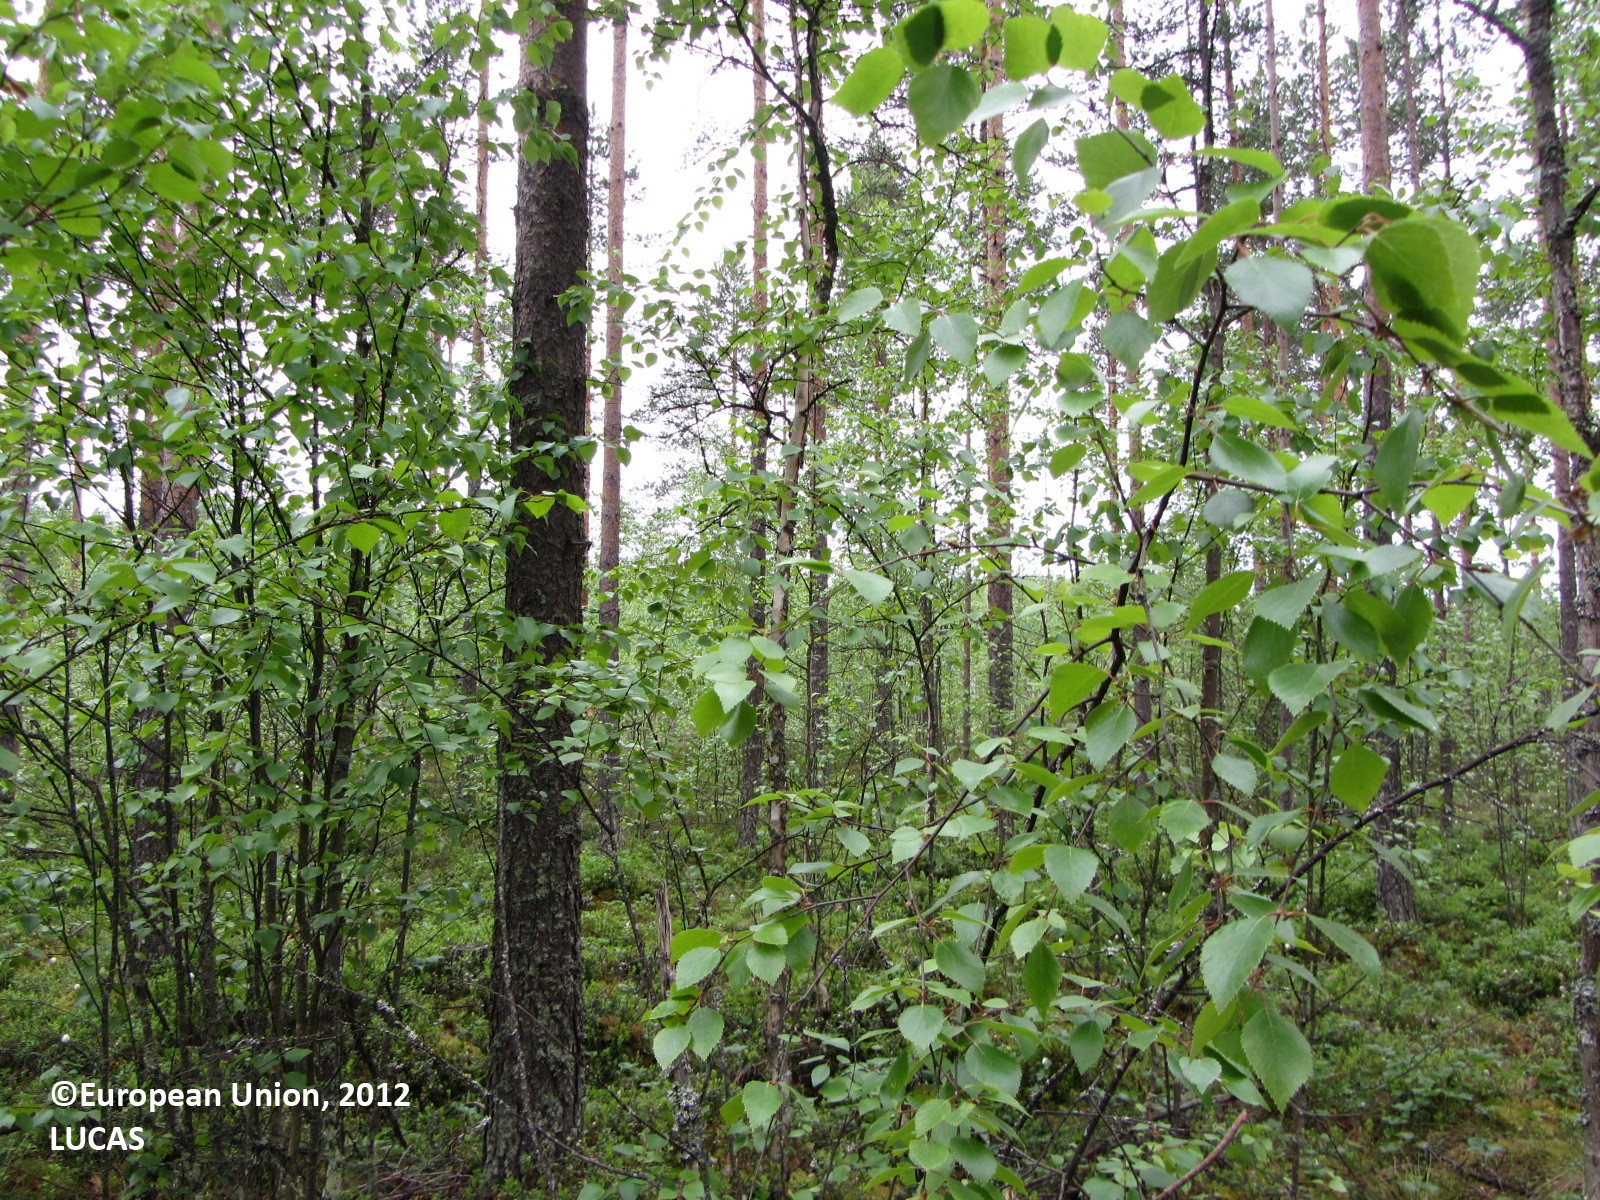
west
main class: Woodland
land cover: Pine dominated mixed woodland
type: boreal forest
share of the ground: 50 - 75 %
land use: Forestry
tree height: > 5 m
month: June
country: FI
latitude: 61.9634
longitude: 25.1948
